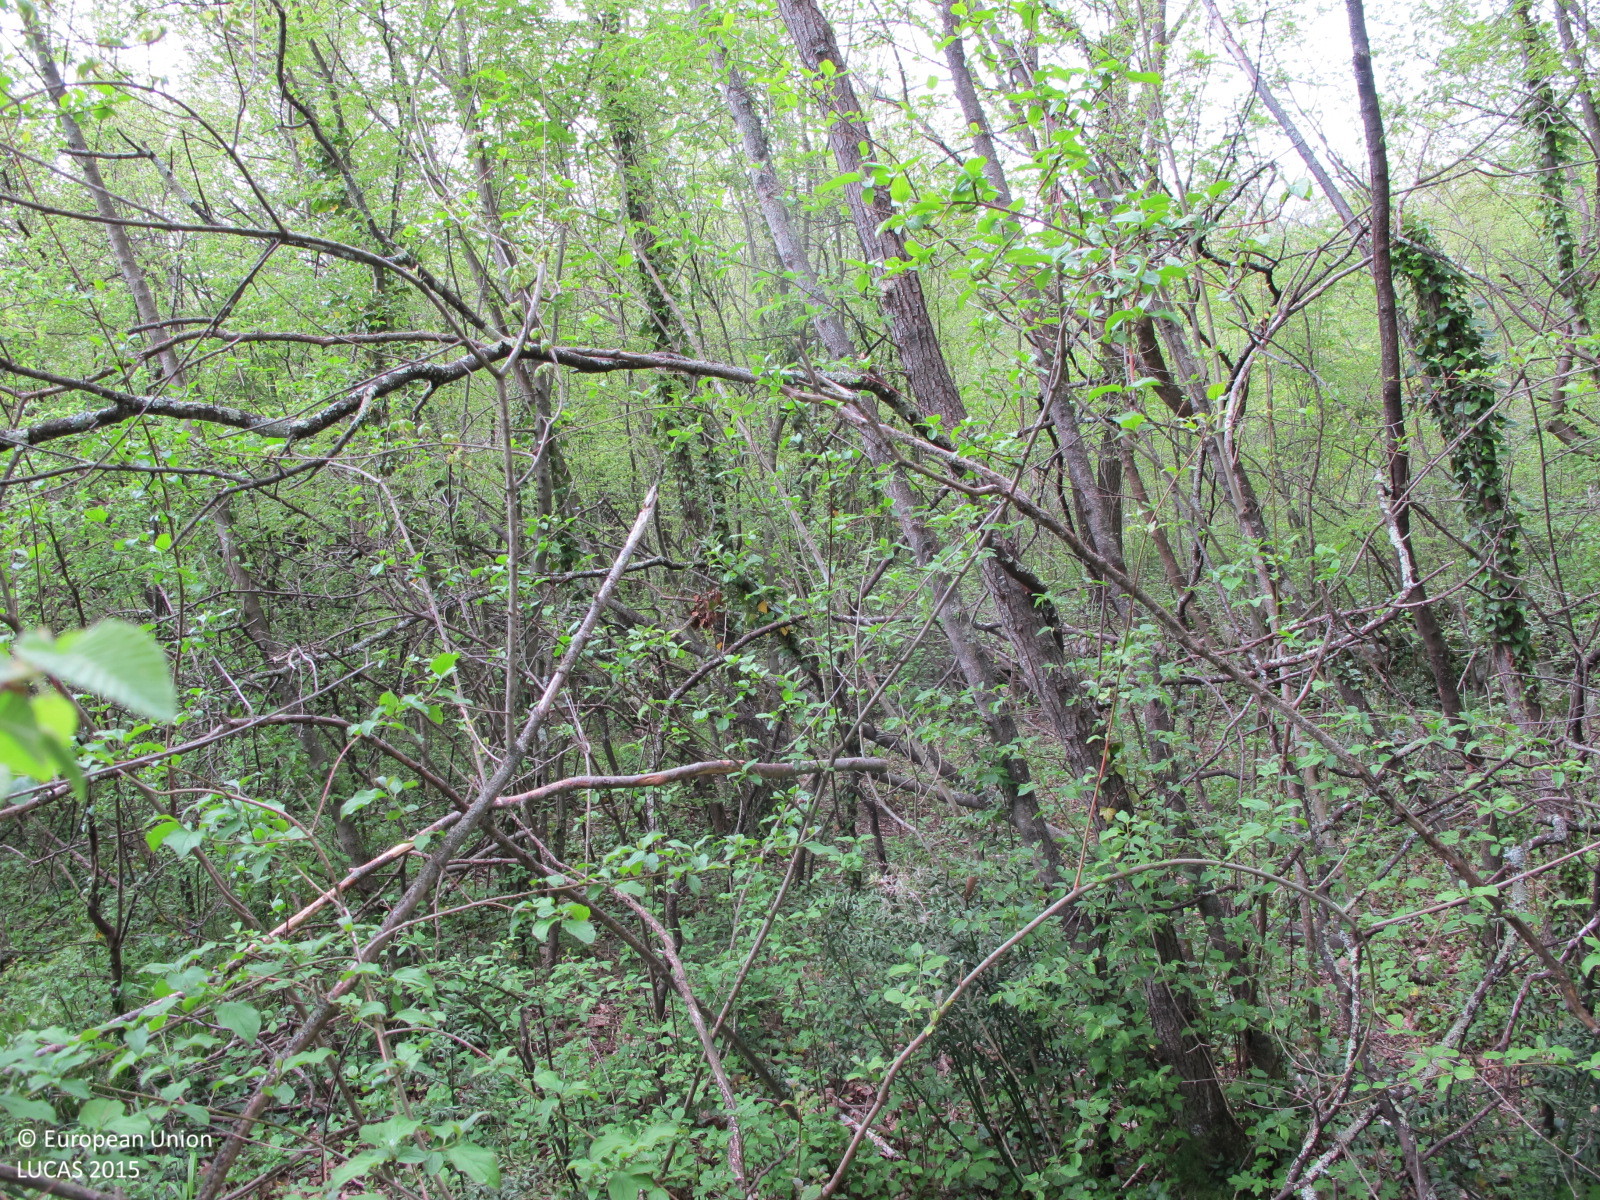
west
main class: Woodland
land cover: Broadleaved woodland
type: thermophilous deciduous forest
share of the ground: > 75 %
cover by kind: broadleaved forest trees 70 %, shrubs 15 %, herbaceous plants 5 %
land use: Semi-natural and natural areas not in use
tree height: > 5 m
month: April
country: HR
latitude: 45.2229
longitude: 14.6177
